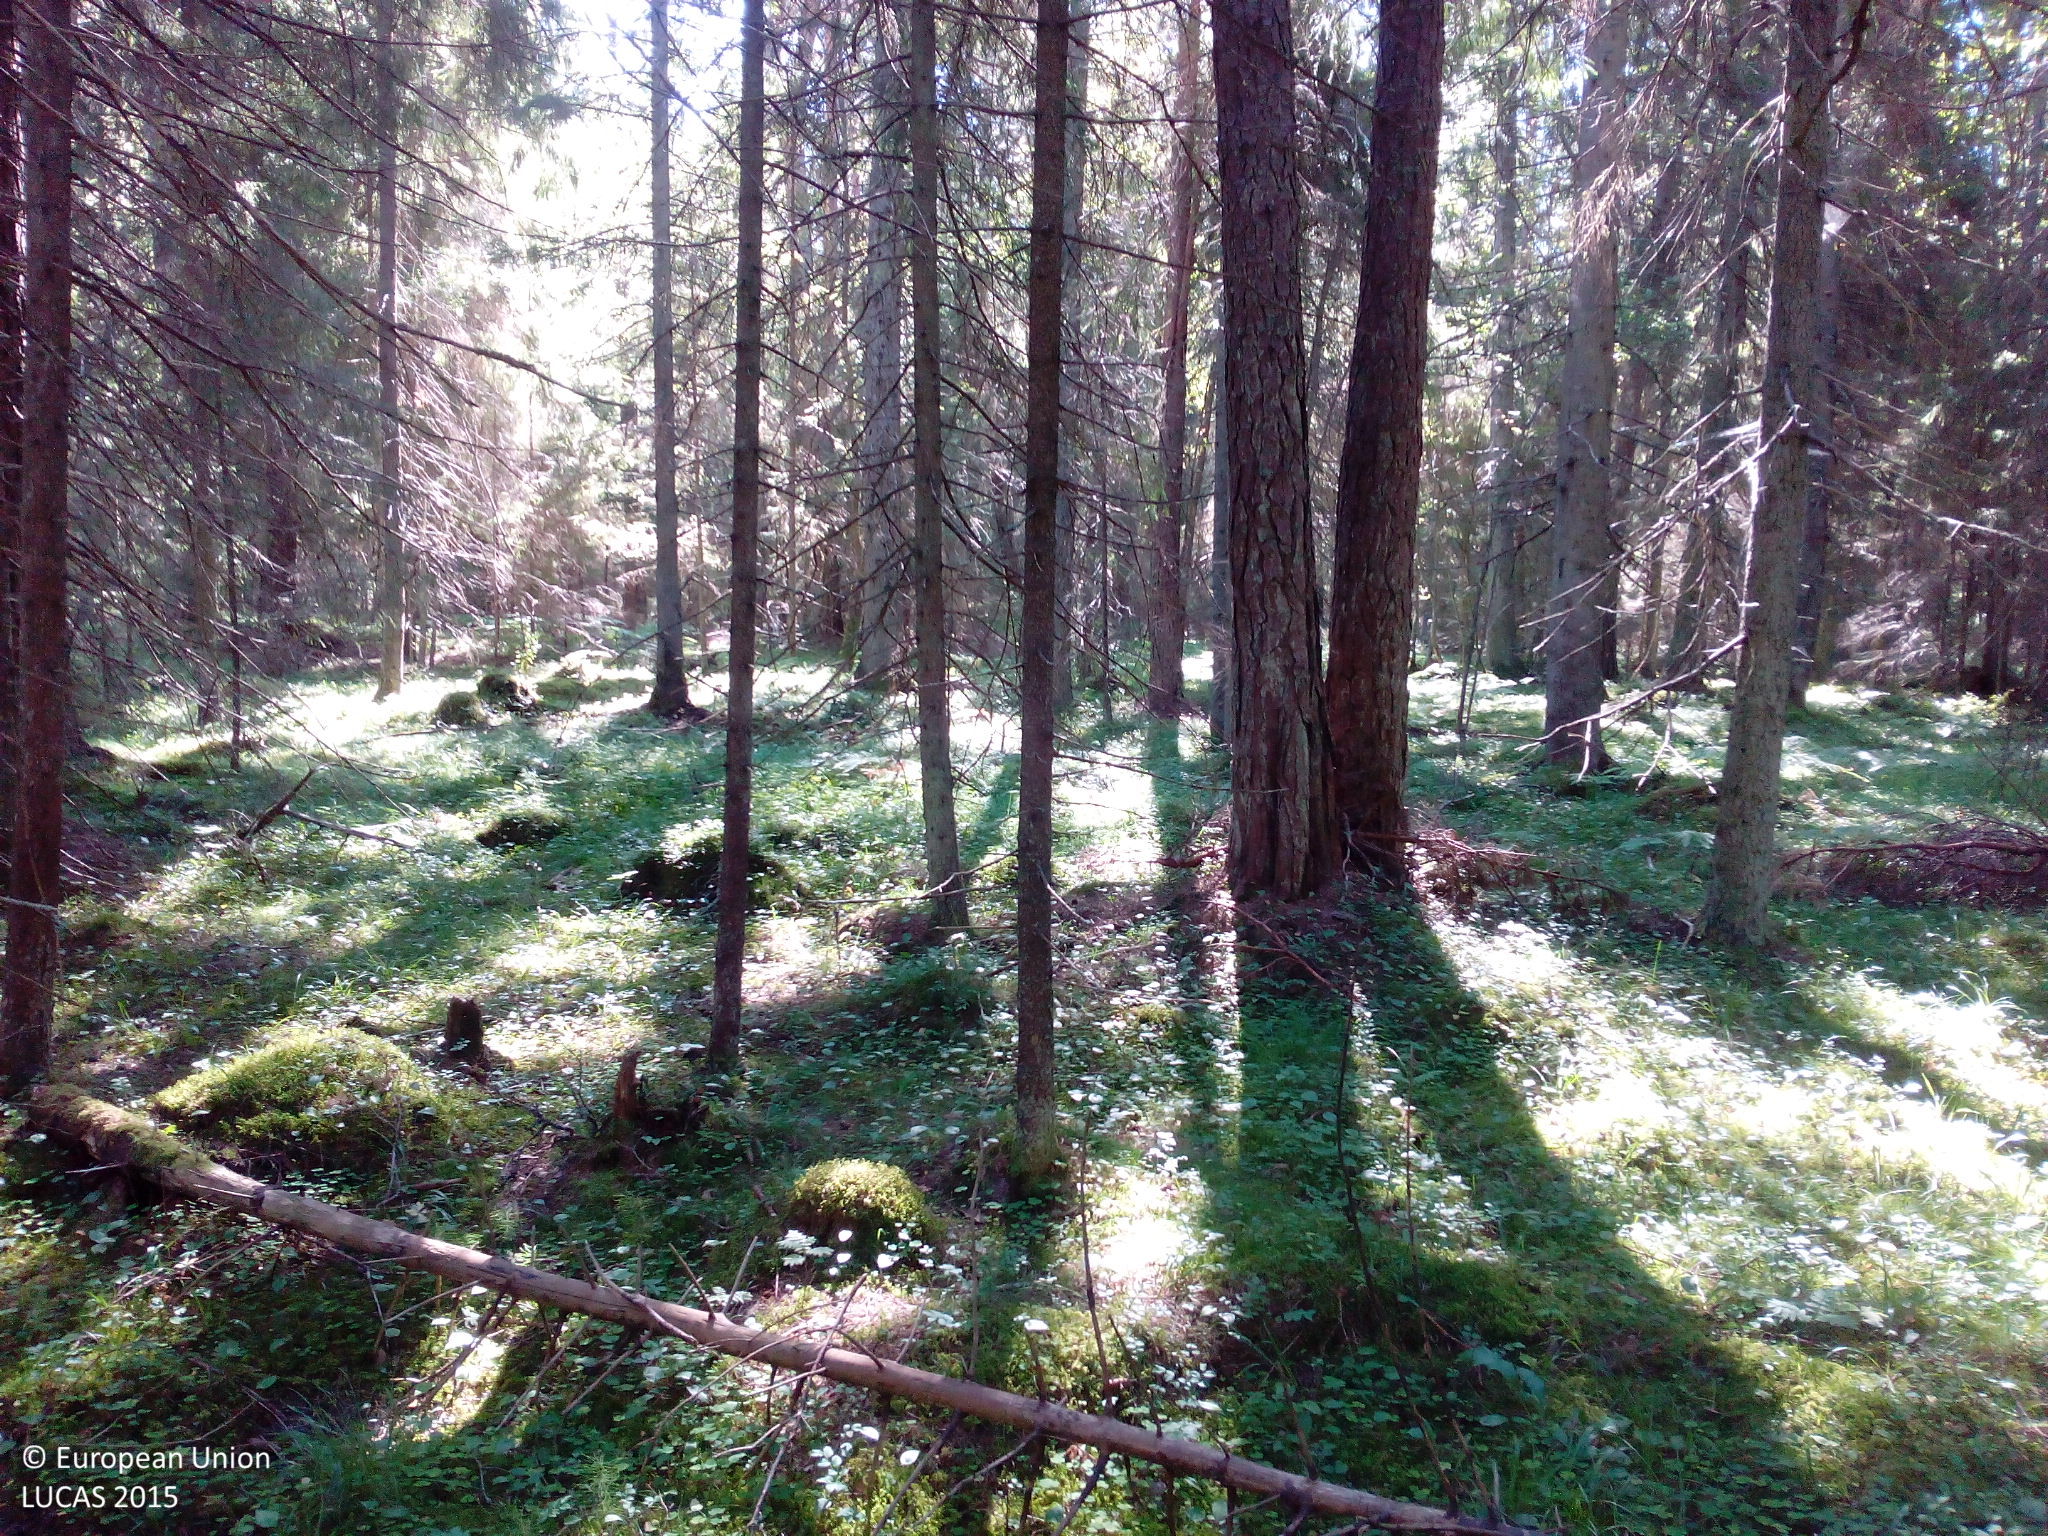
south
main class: Woodland
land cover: Spruce dominated coniferous woodland
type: hemiboreal forest and nemoral coniferous forest and mixed broadleaved-coniferous forest
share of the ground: > 75 %
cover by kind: coniferous forest trees 90 %, herbaceous plants 5 %, lichens and mosses 5 %
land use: Forestry
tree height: > 5 m
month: August
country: FI
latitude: 60.1410
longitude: 19.8921
